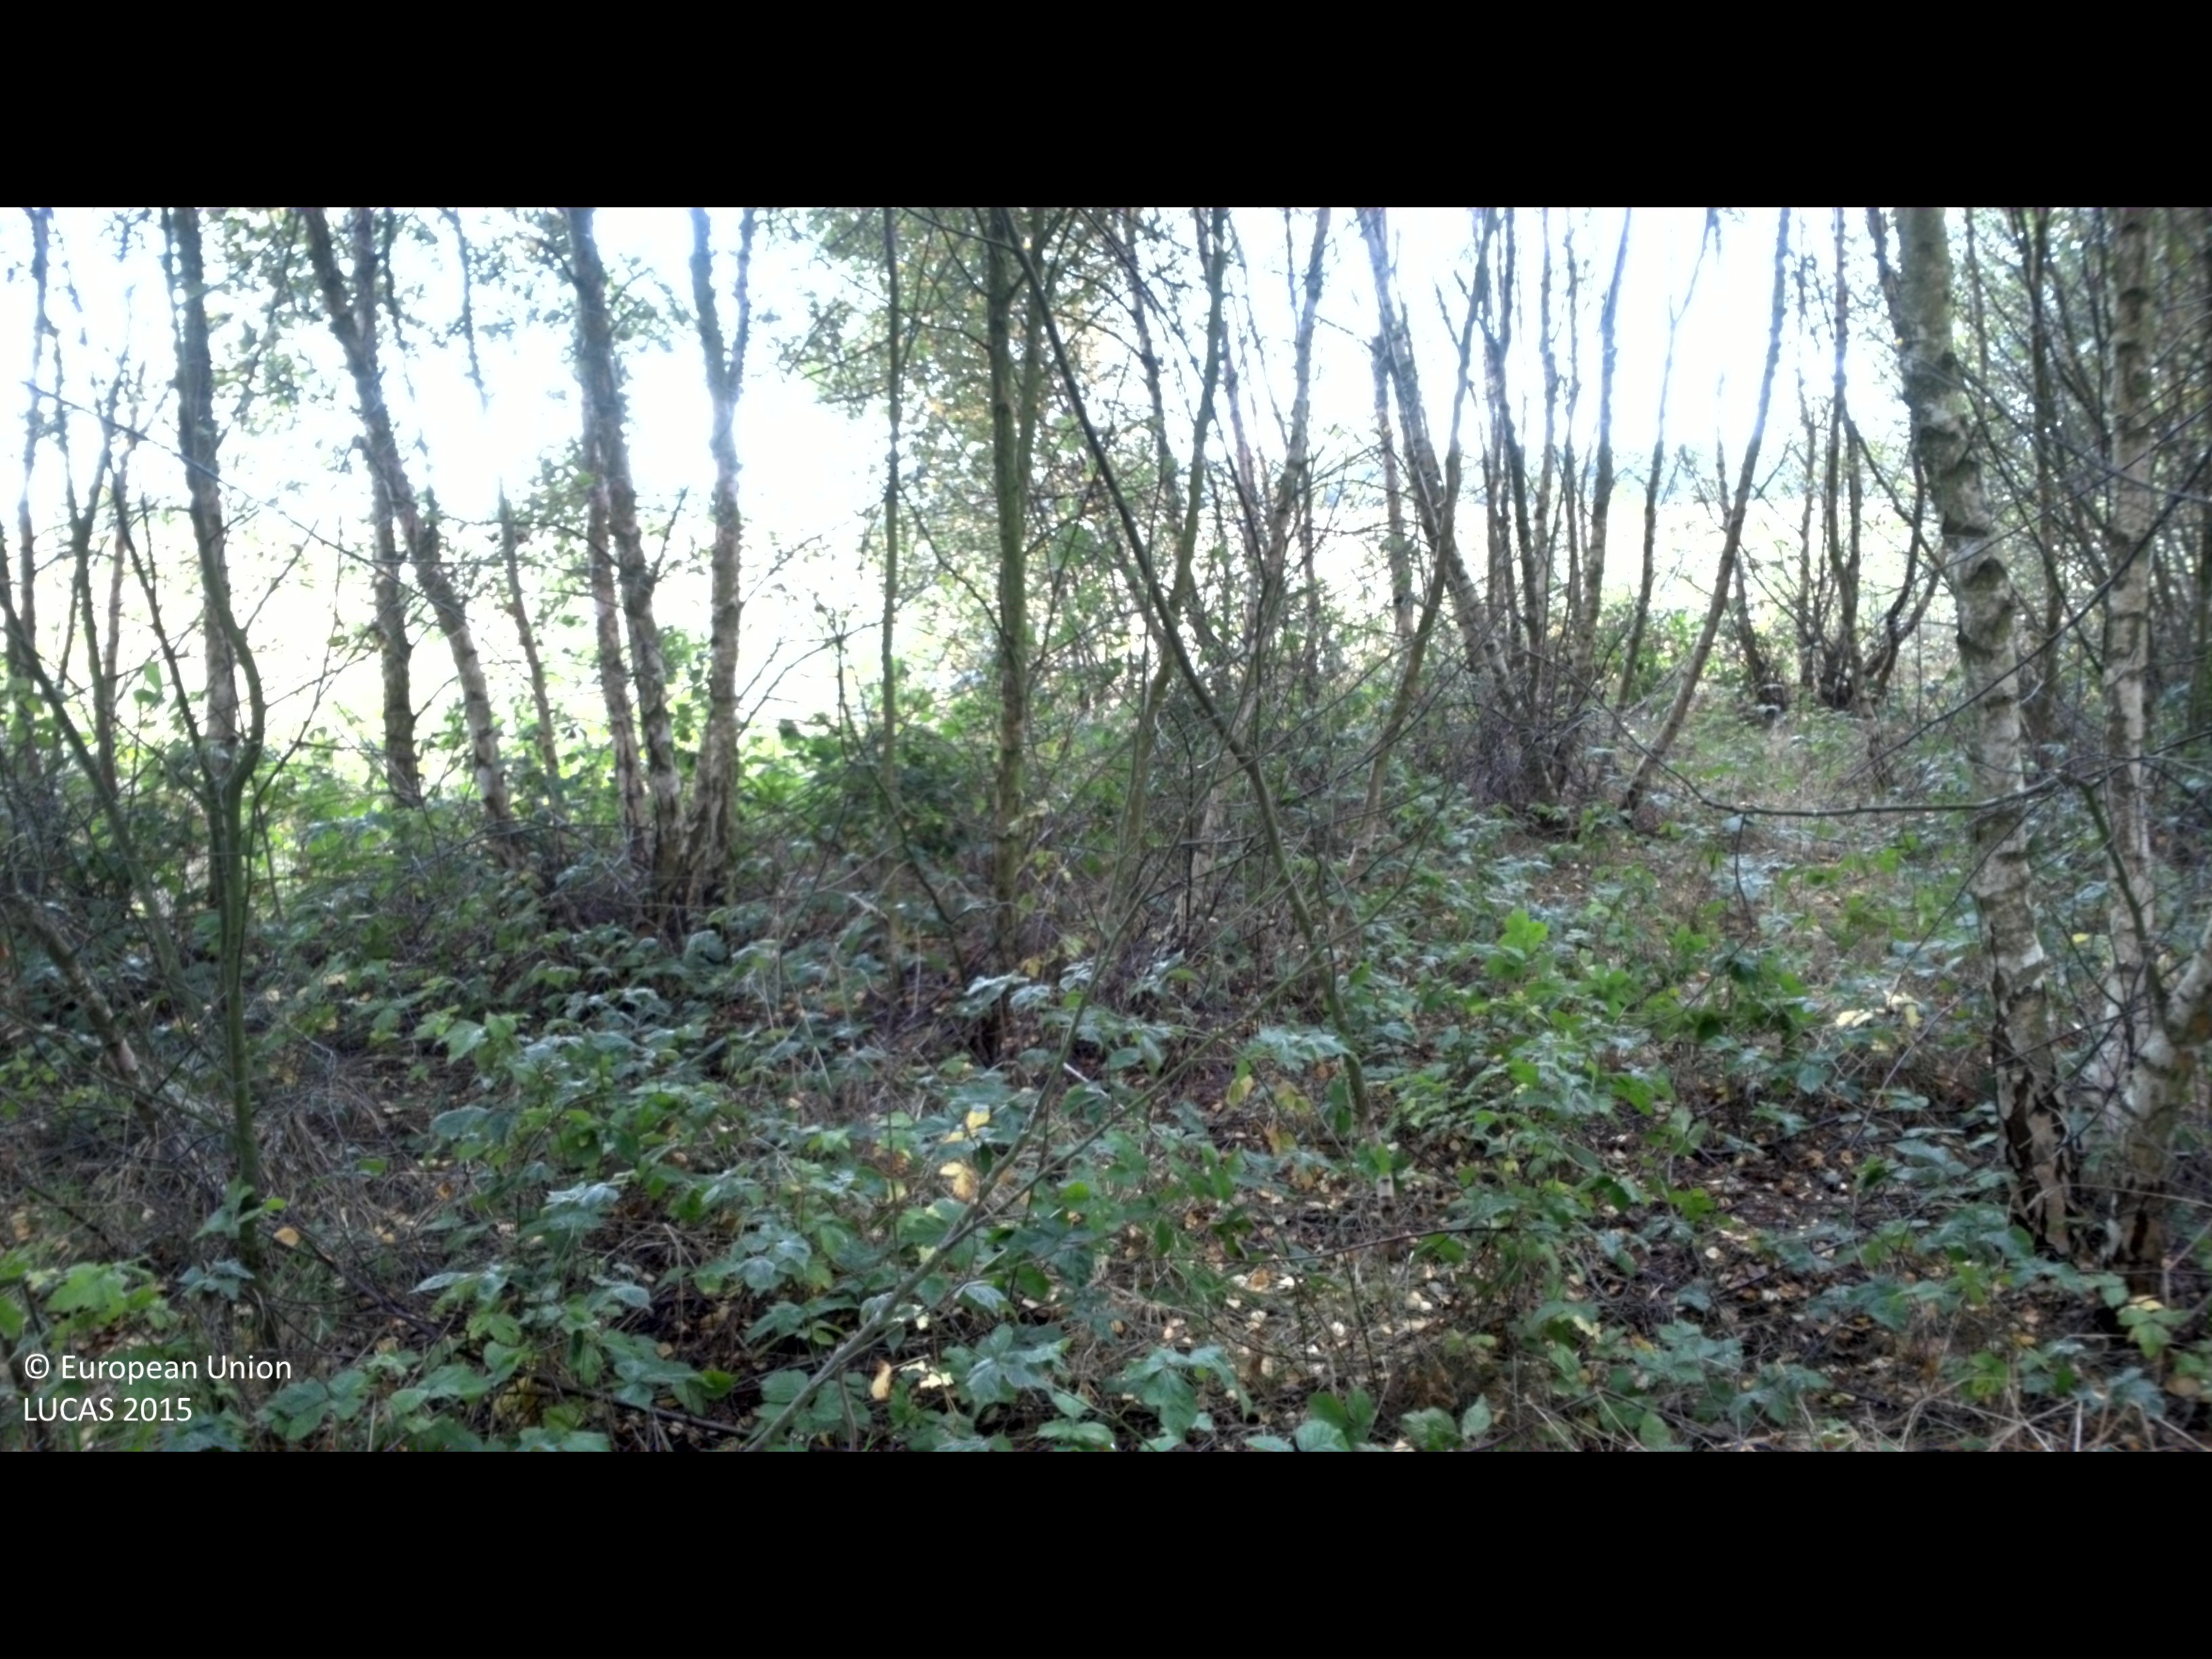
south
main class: Woodland
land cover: Broadleaved woodland
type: hemiboreal forest and nemoral coniferous forest and mixed broadleaved-coniferous forest
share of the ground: > 75 %
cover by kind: broadleaved forest trees 85 %, shrubs 10 %, herbaceous plants 5 %
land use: Agriculture (excluding fallow land and kitchen gardens)
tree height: < 5 m
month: September
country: SE
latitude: 55.9862
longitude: 14.4062
